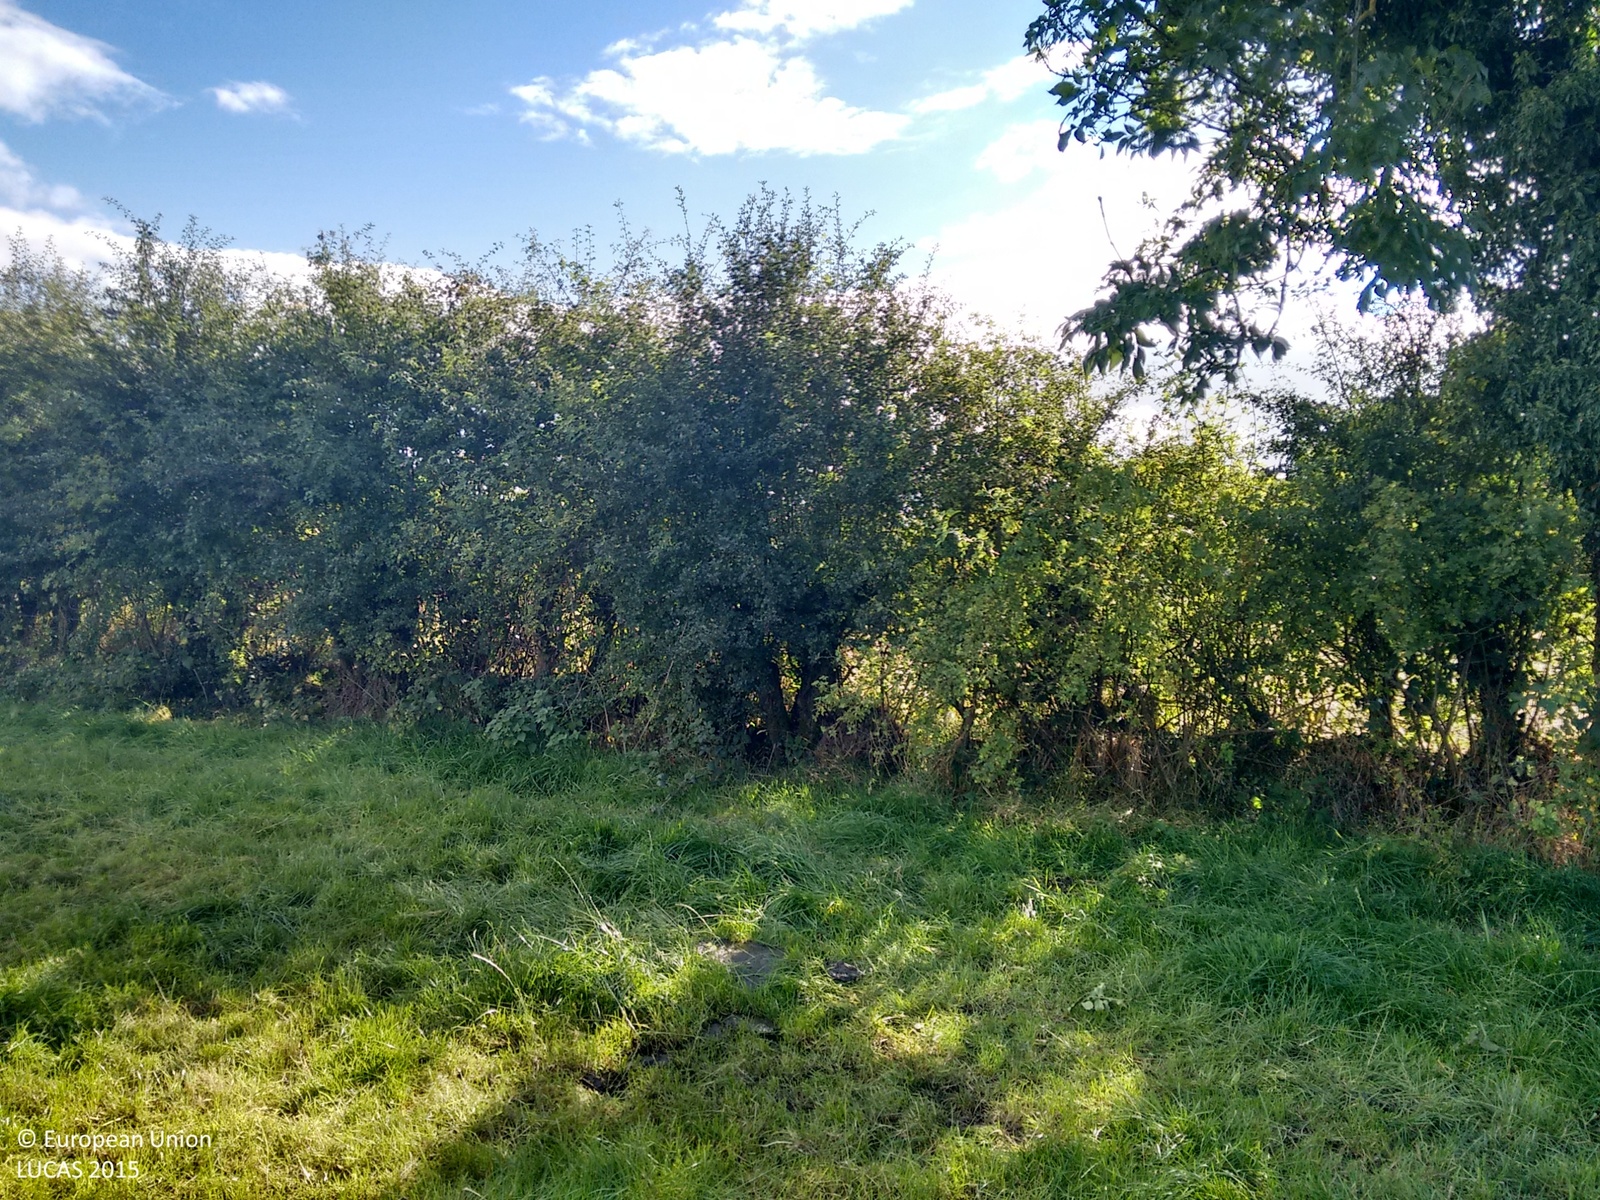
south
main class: Grassland
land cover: Grassland without tree/shrub cover
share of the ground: > 75 %
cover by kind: herbaceous plants 95 %, shrubs 5 %
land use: Agriculture (excluding fallow land and kitchen gardens)
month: September
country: IE
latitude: 54.2335
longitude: -6.8425
